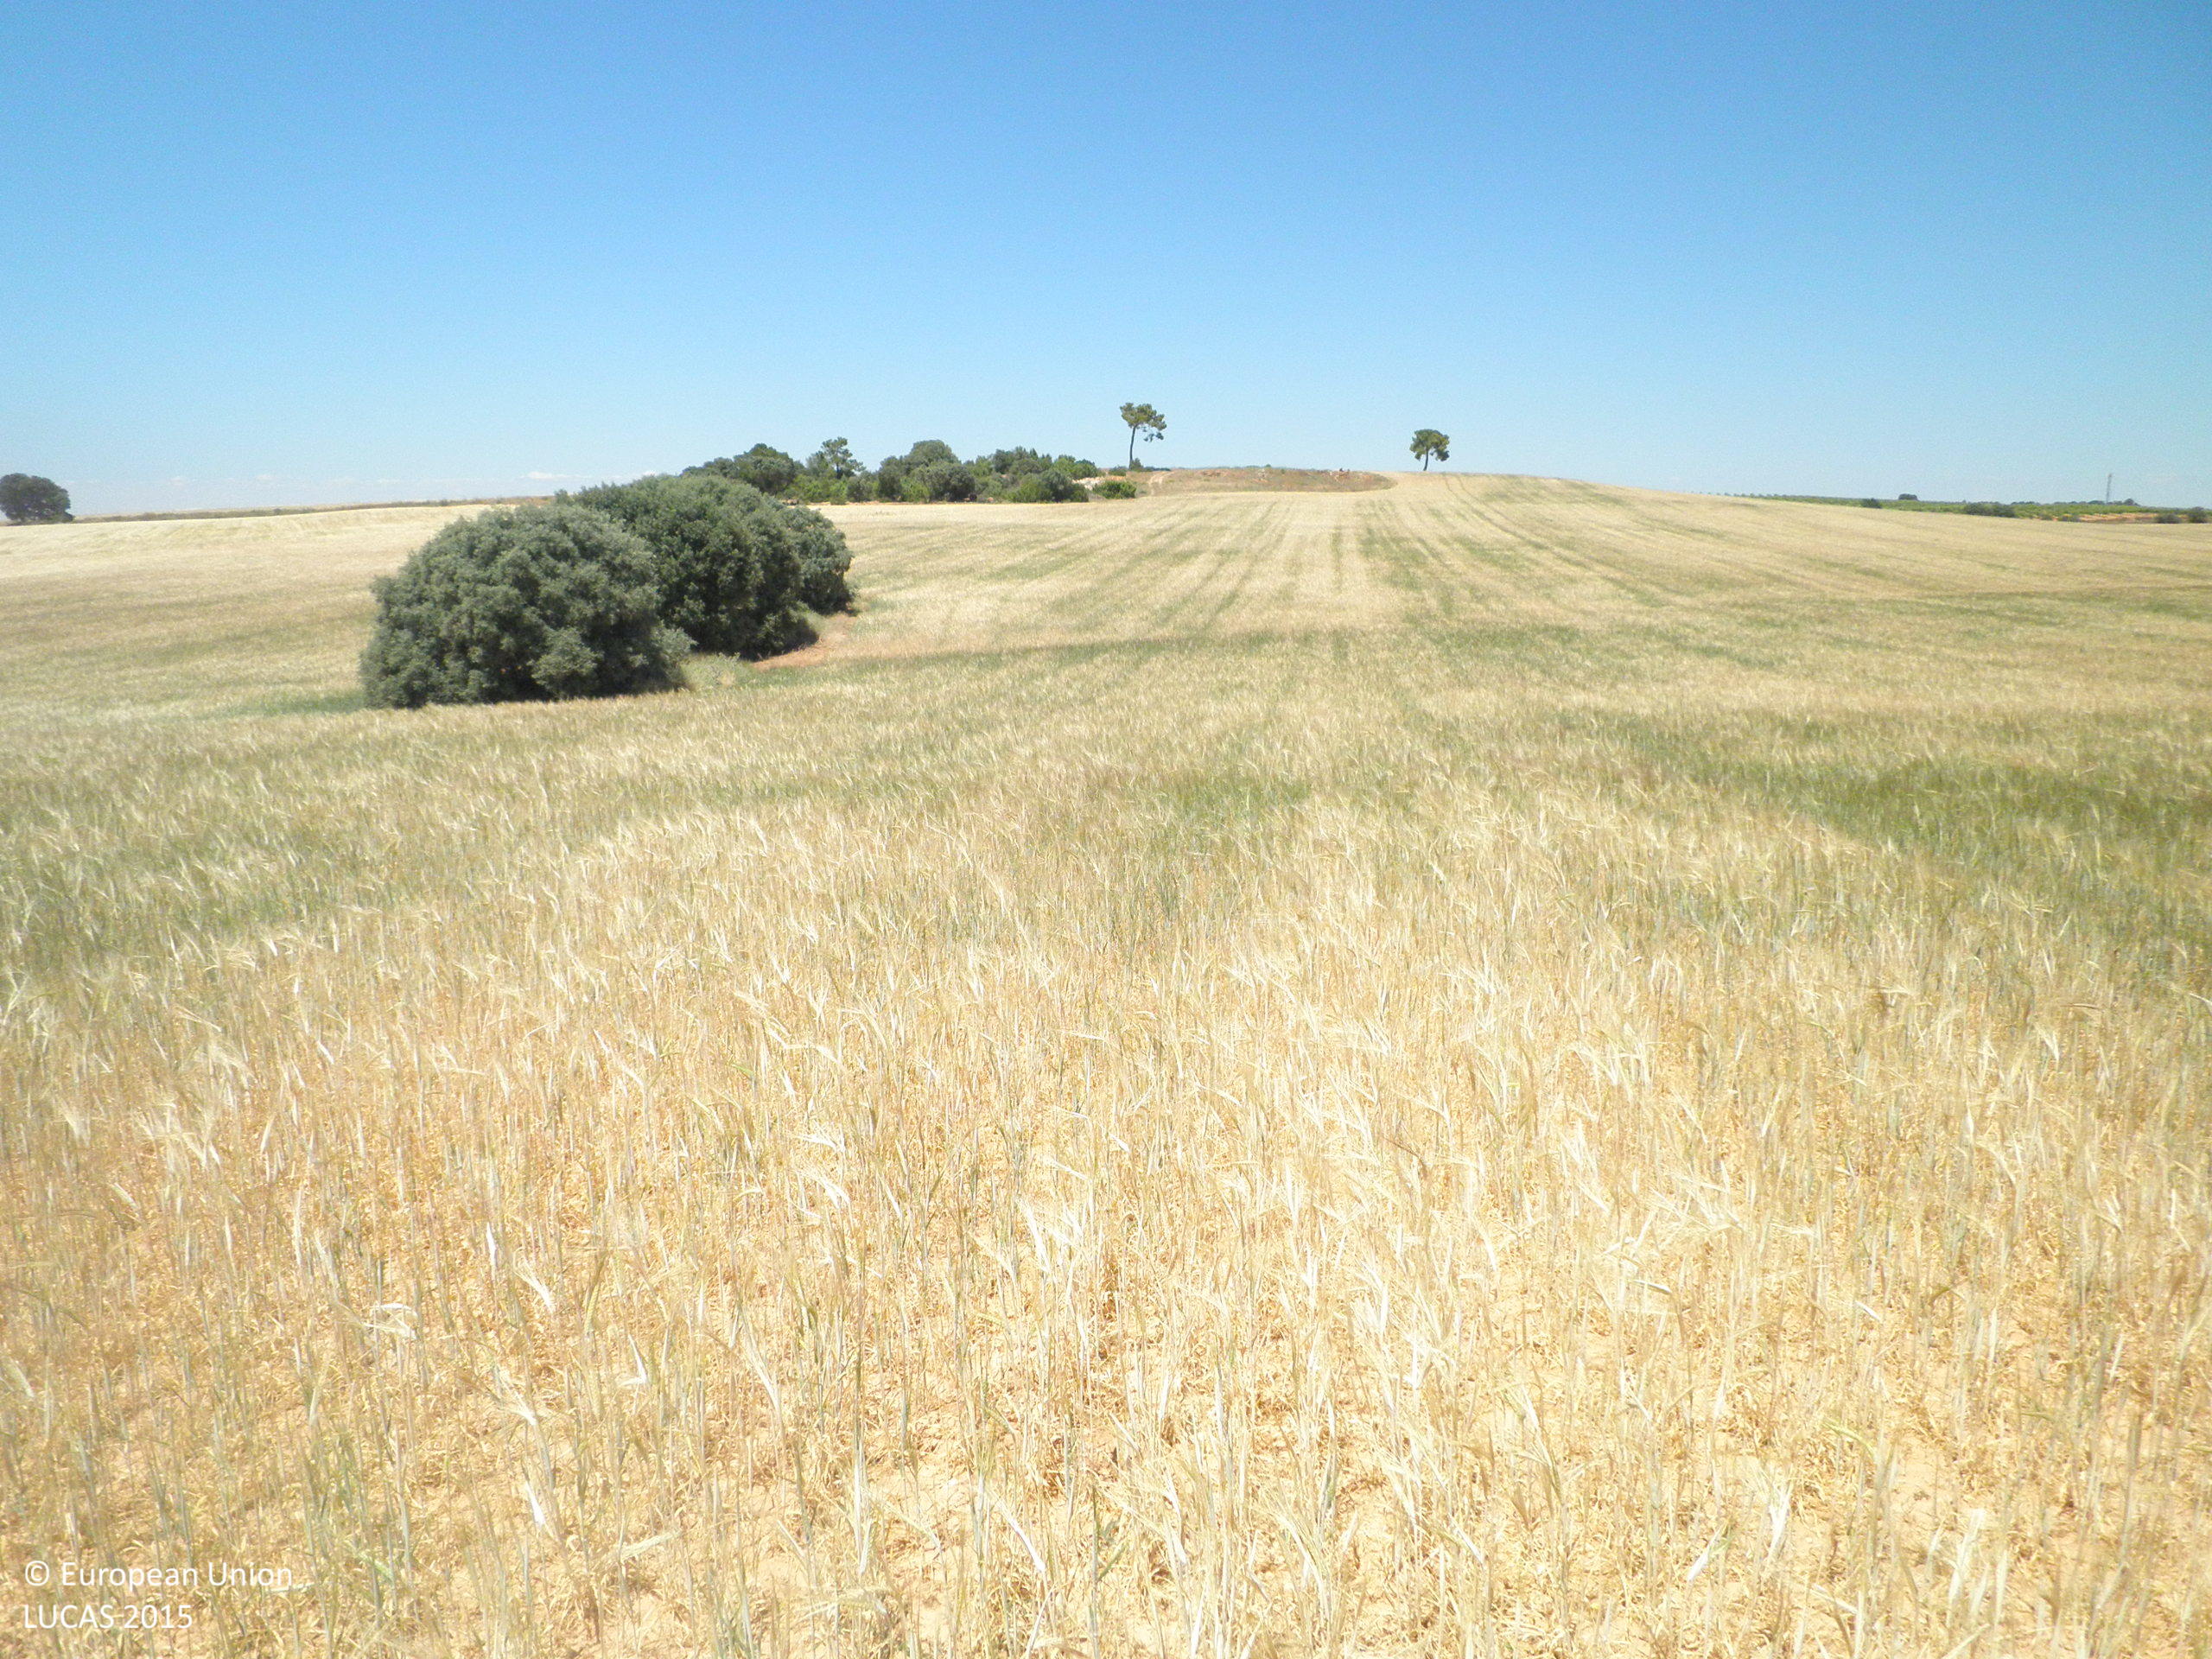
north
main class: Cropland
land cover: Barley
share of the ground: 50 - 75 %
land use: Agriculture (excluding fallow land and kitchen gardens)
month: June
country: ES
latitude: 39.4955
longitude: -1.6682
